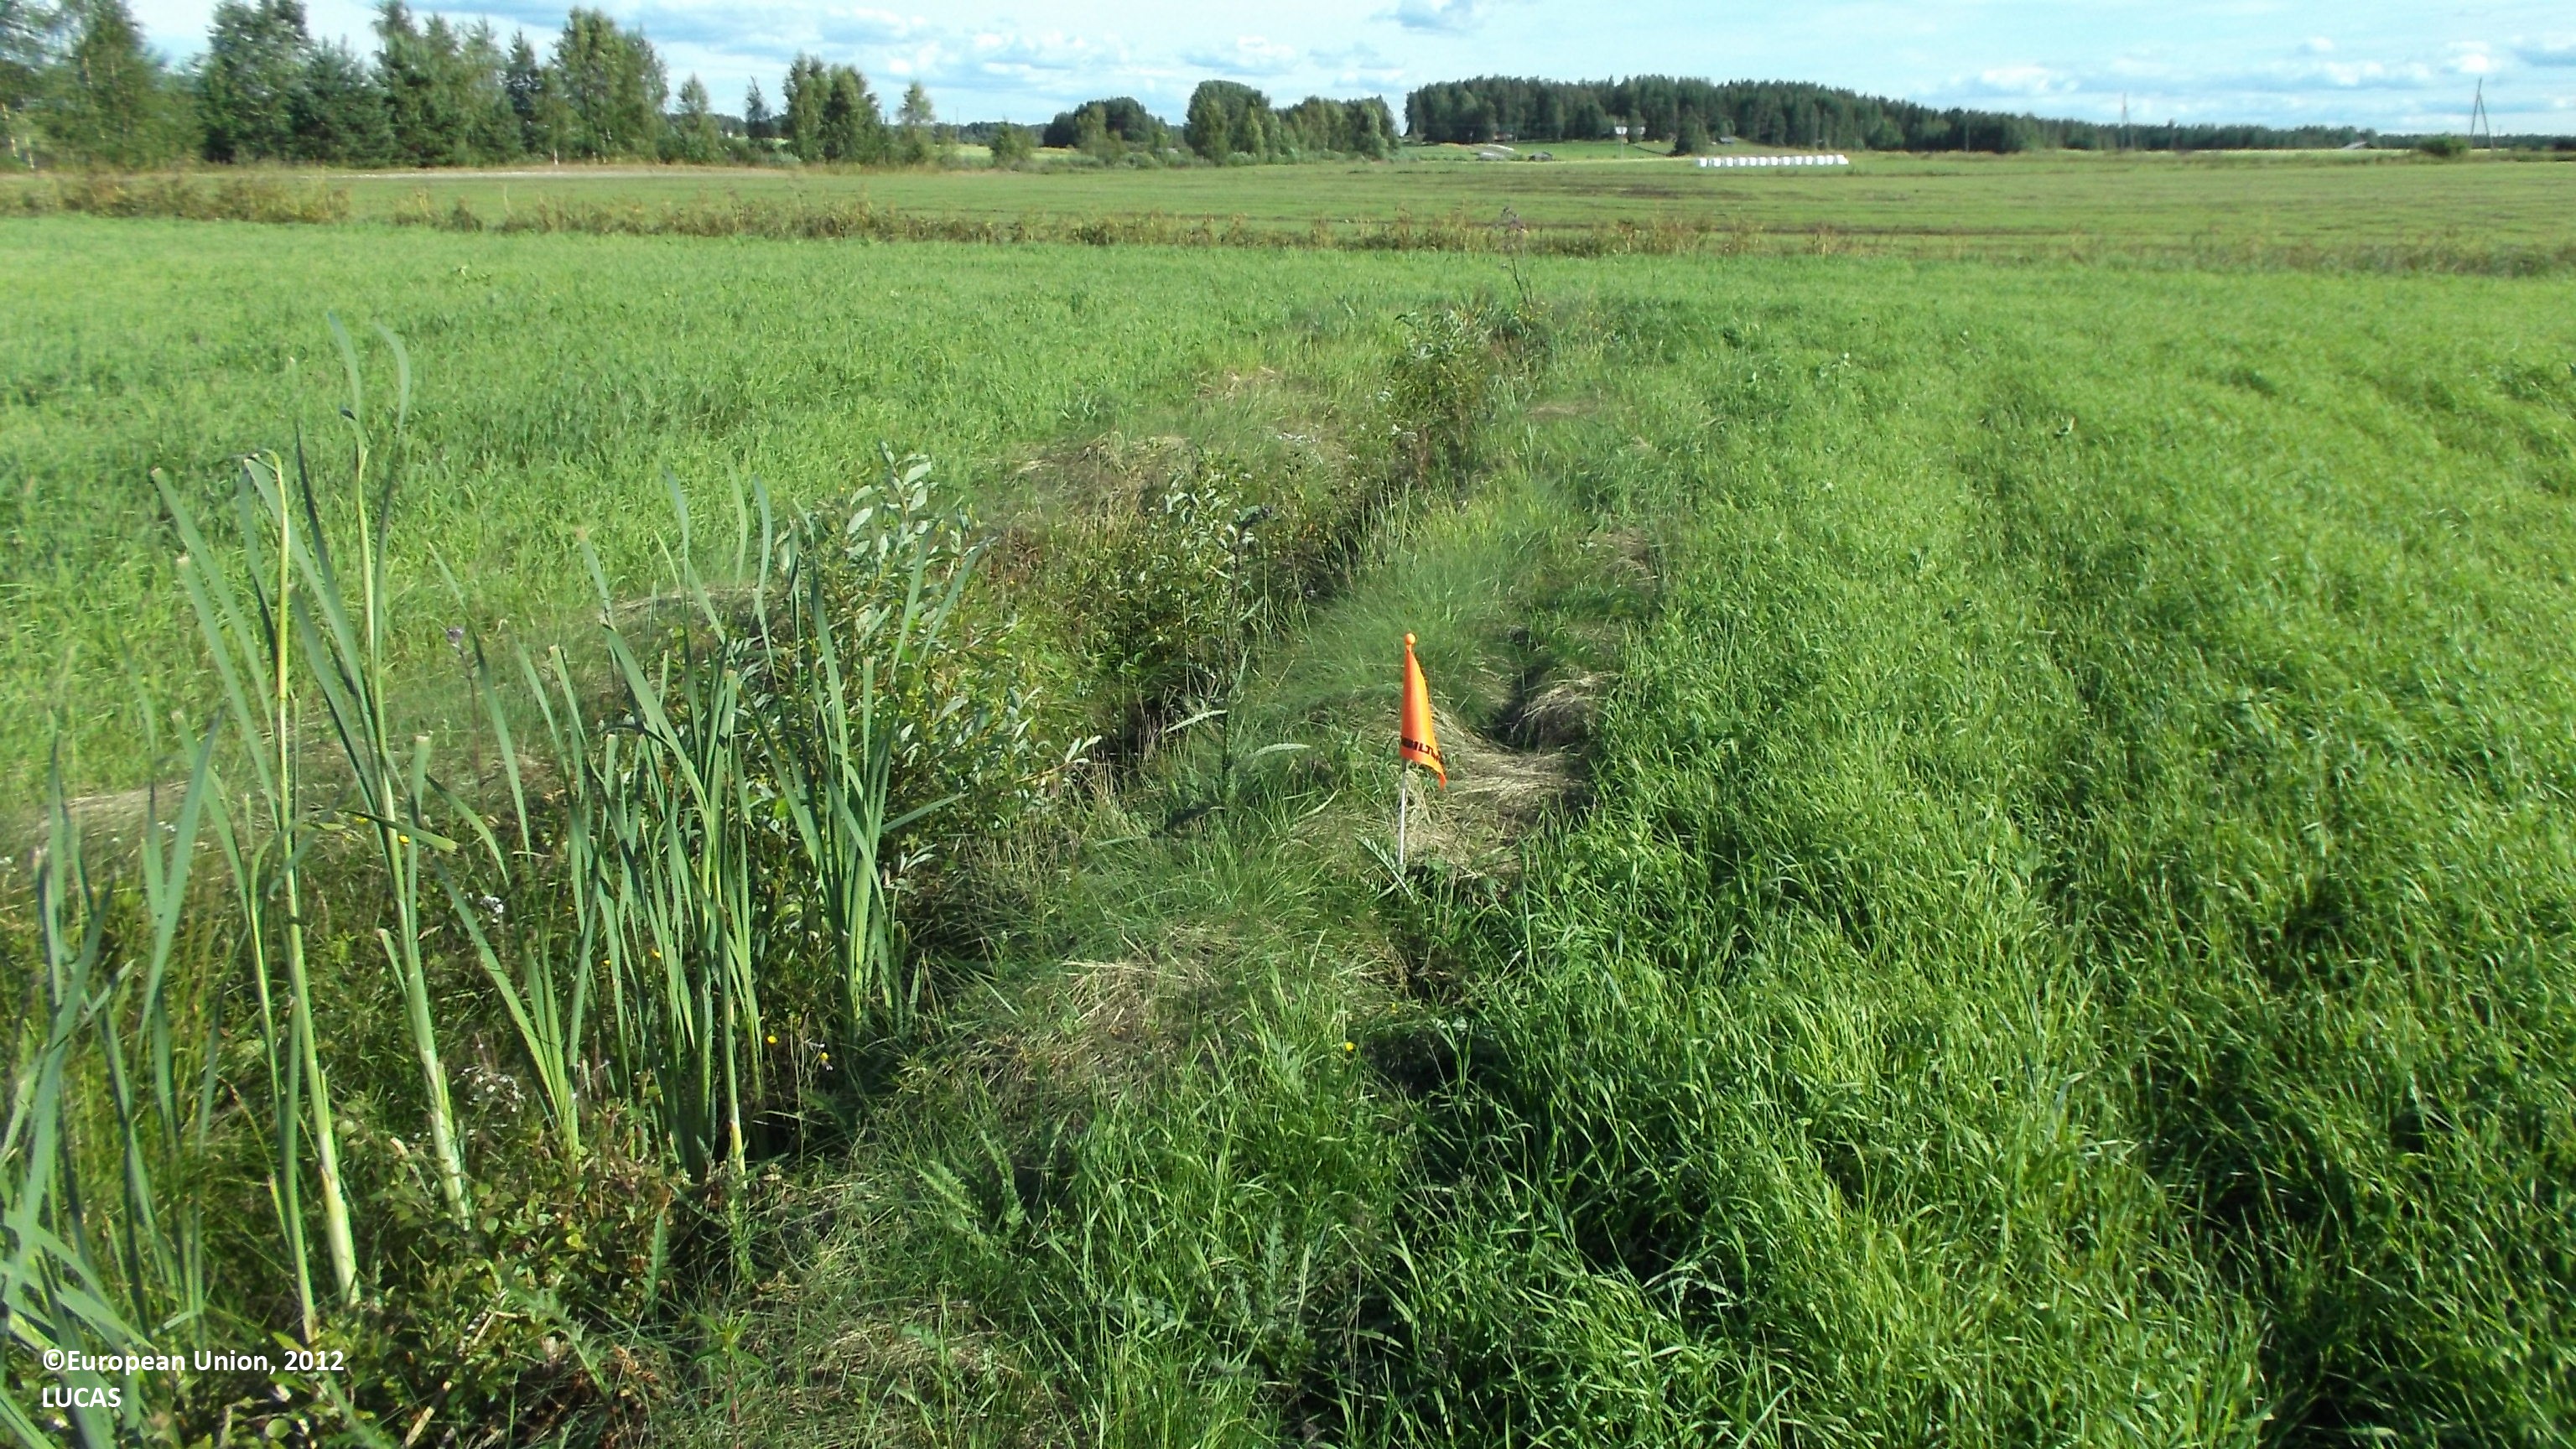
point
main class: Cropland
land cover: Temporary grasslands
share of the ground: > 75 %
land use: Agriculture (excluding fallow land and kitchen gardens)
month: July
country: FI
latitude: 63.2625
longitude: 23.7554
